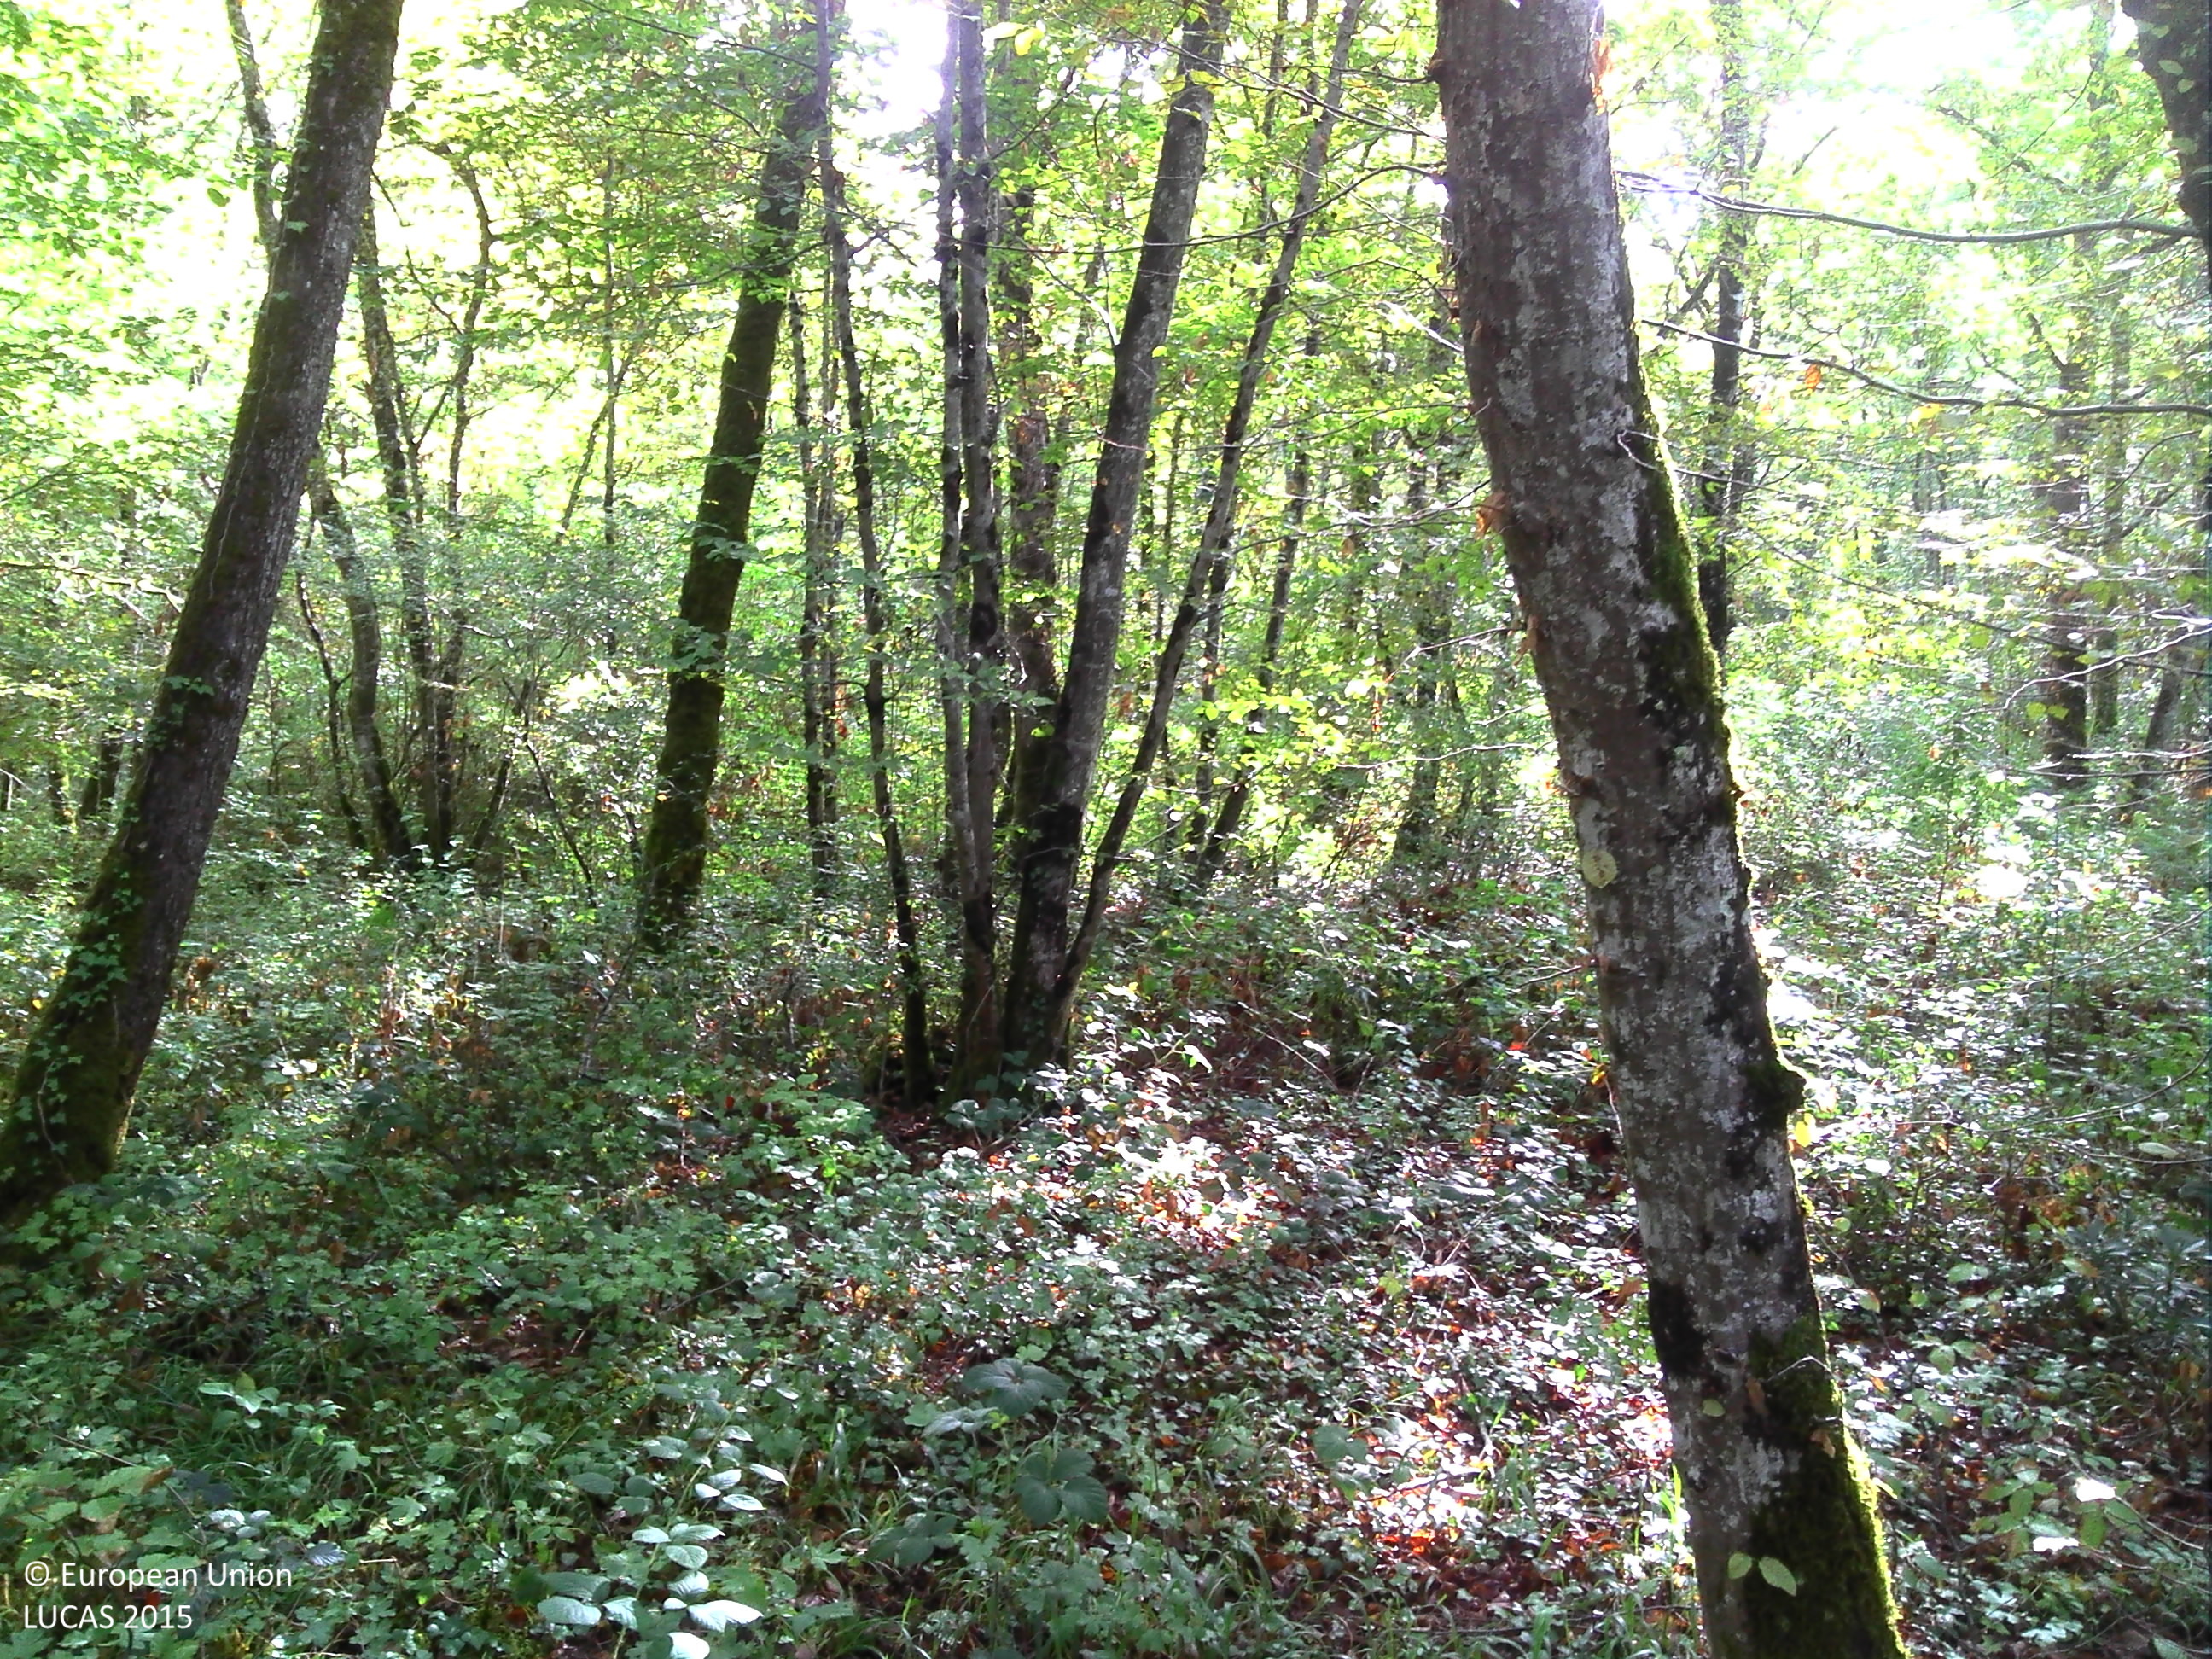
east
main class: Woodland
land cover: Broadleaved woodland
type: mesophytic deciduous forest
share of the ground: > 75 %
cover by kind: broadleaved forest trees 90 %, herbaceous plants 5 %, lichens and mosses 5 %
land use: Forestry
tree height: > 5 m
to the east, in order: Broadleaved woodland
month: September
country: FR
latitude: 48.1330
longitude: 4.7176
